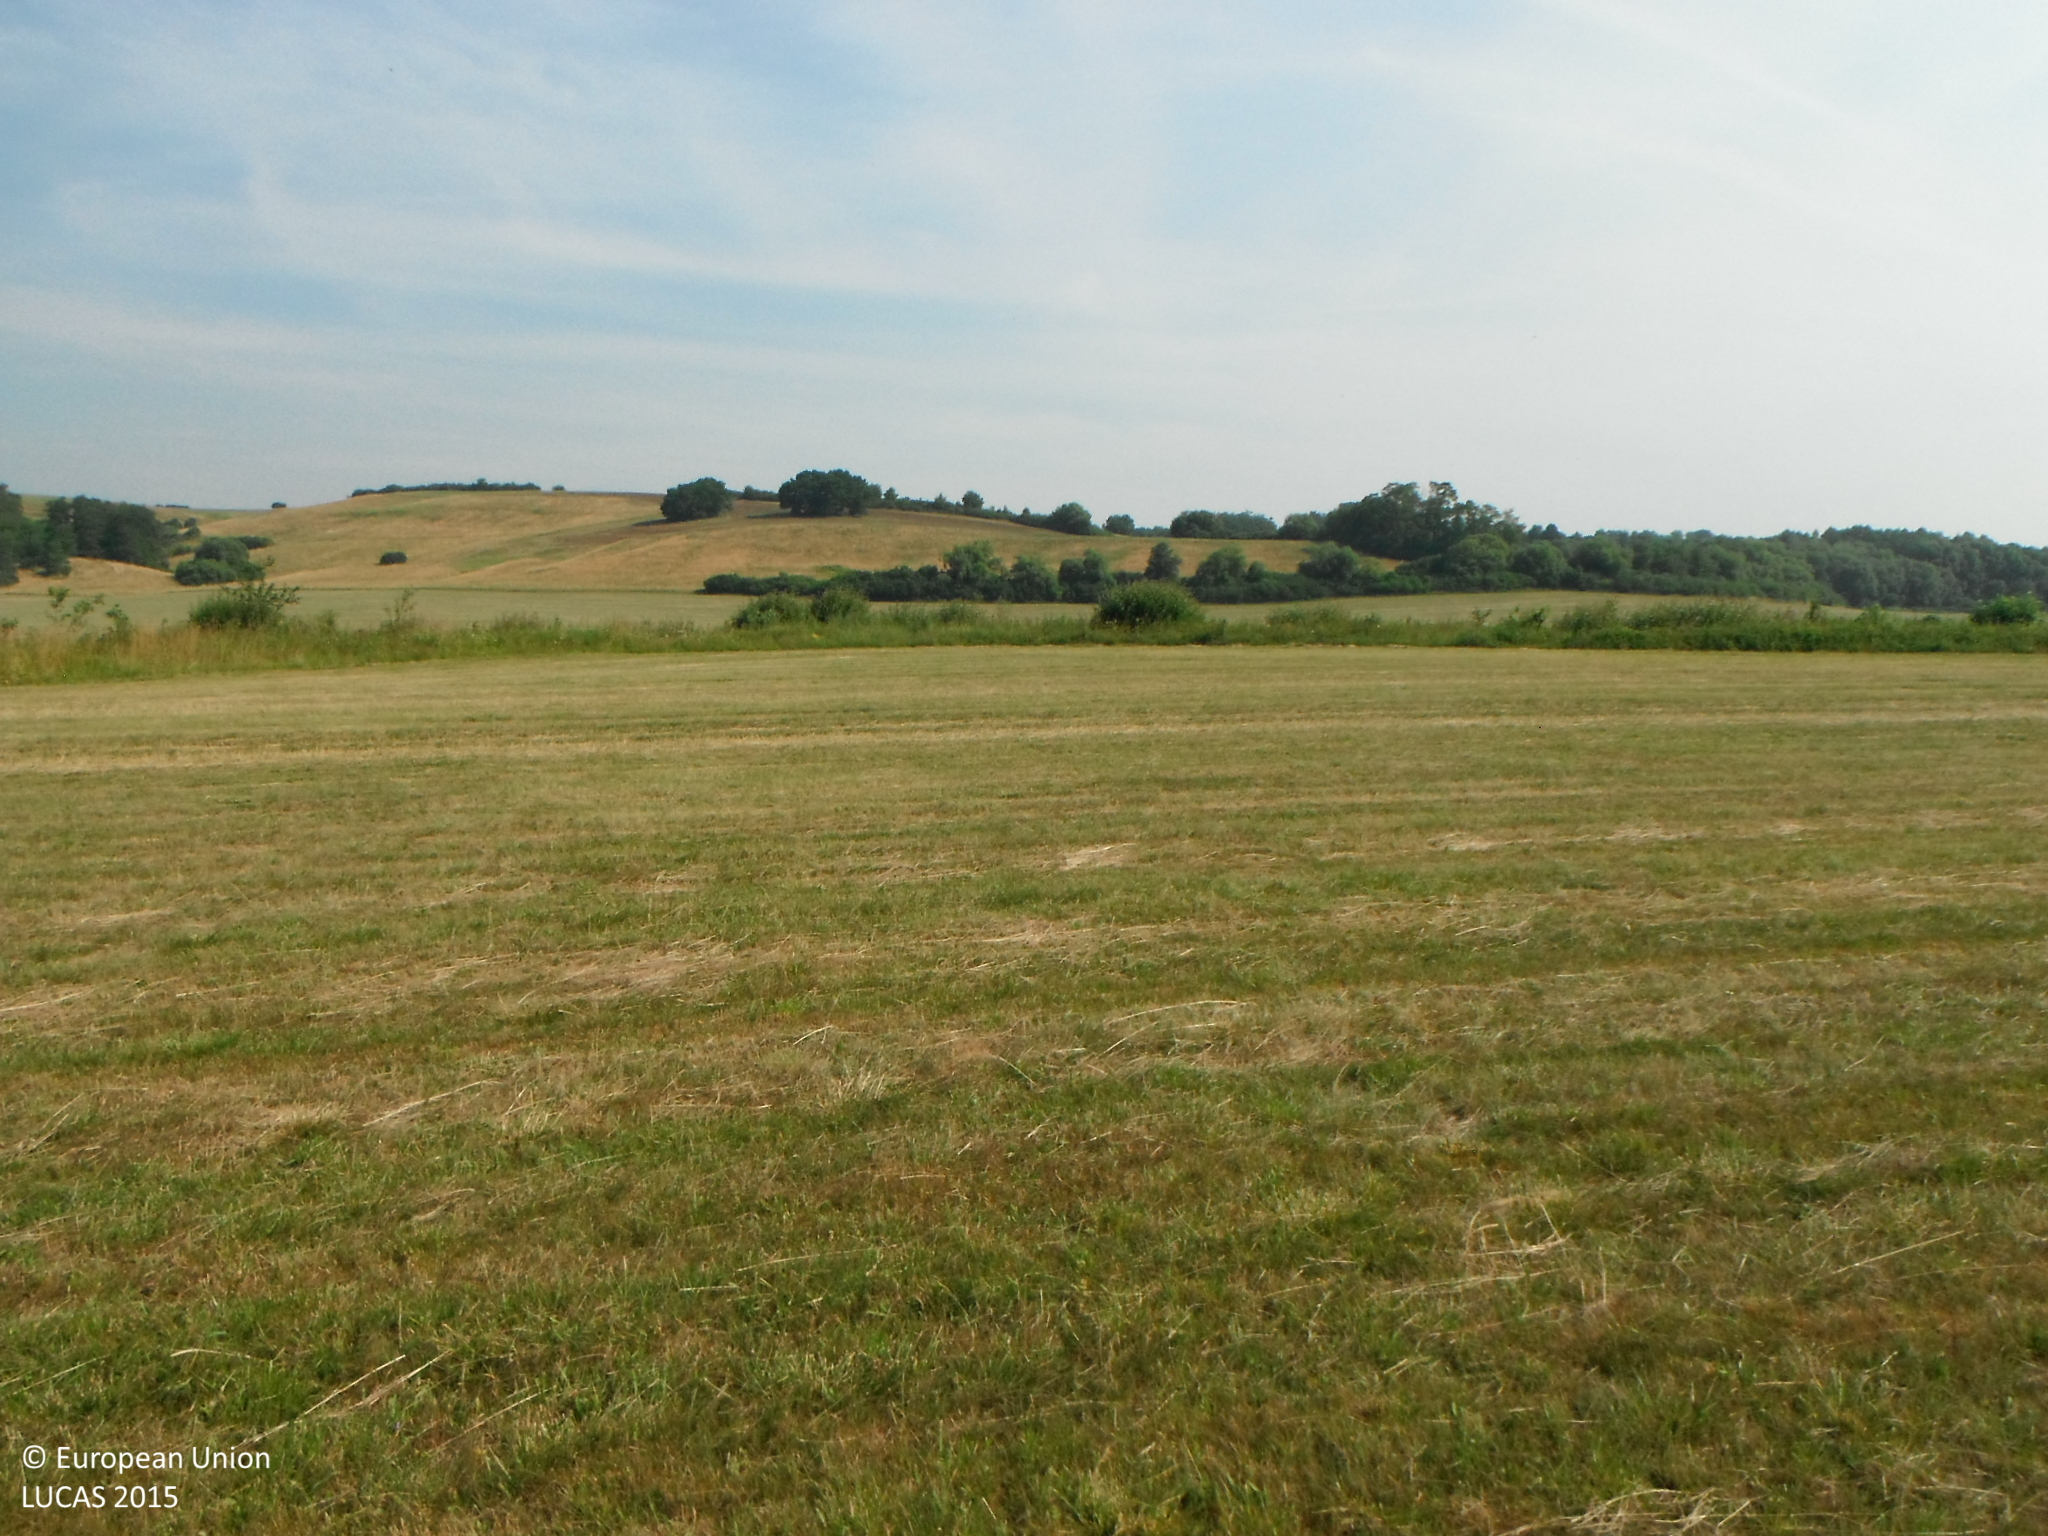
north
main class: Grassland
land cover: Grassland without tree/shrub cover
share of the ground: > 75 %
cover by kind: herbaceous plants 100 %
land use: Agriculture (excluding fallow land and kitchen gardens)
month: July
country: SK
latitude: 48.5940
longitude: 19.2565
